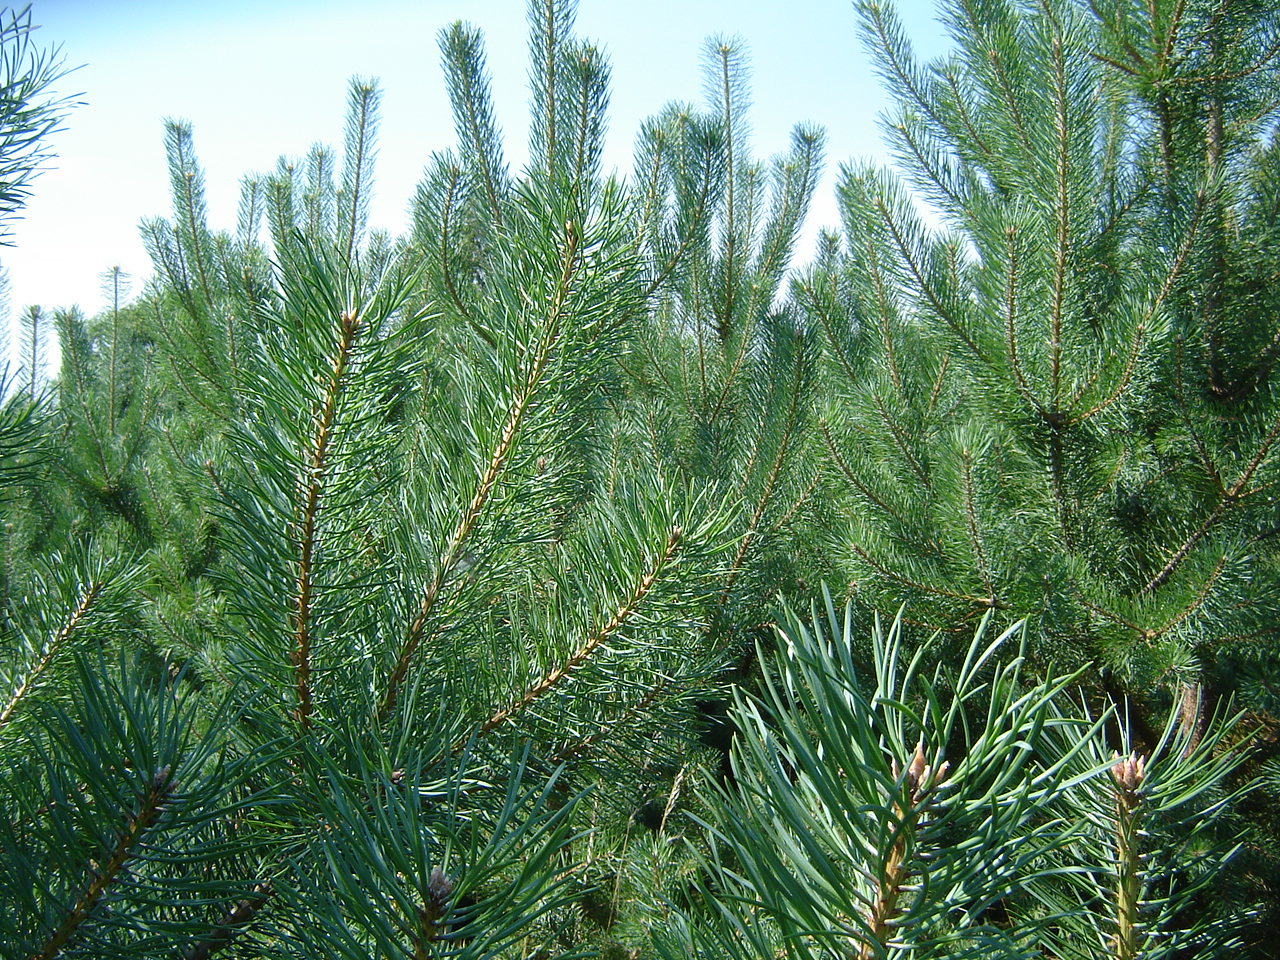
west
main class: Woodland
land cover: Pine dominated coniferous woodland
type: hemiboreal forest and nemoral coniferous forest and mixed broadleaved-coniferous forest
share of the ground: > 75 %
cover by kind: coniferous forest trees 90 %, herbaceous plants 10 %
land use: Forestry
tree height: < 5 m
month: August
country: LT
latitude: 55.2115
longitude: 24.9634
